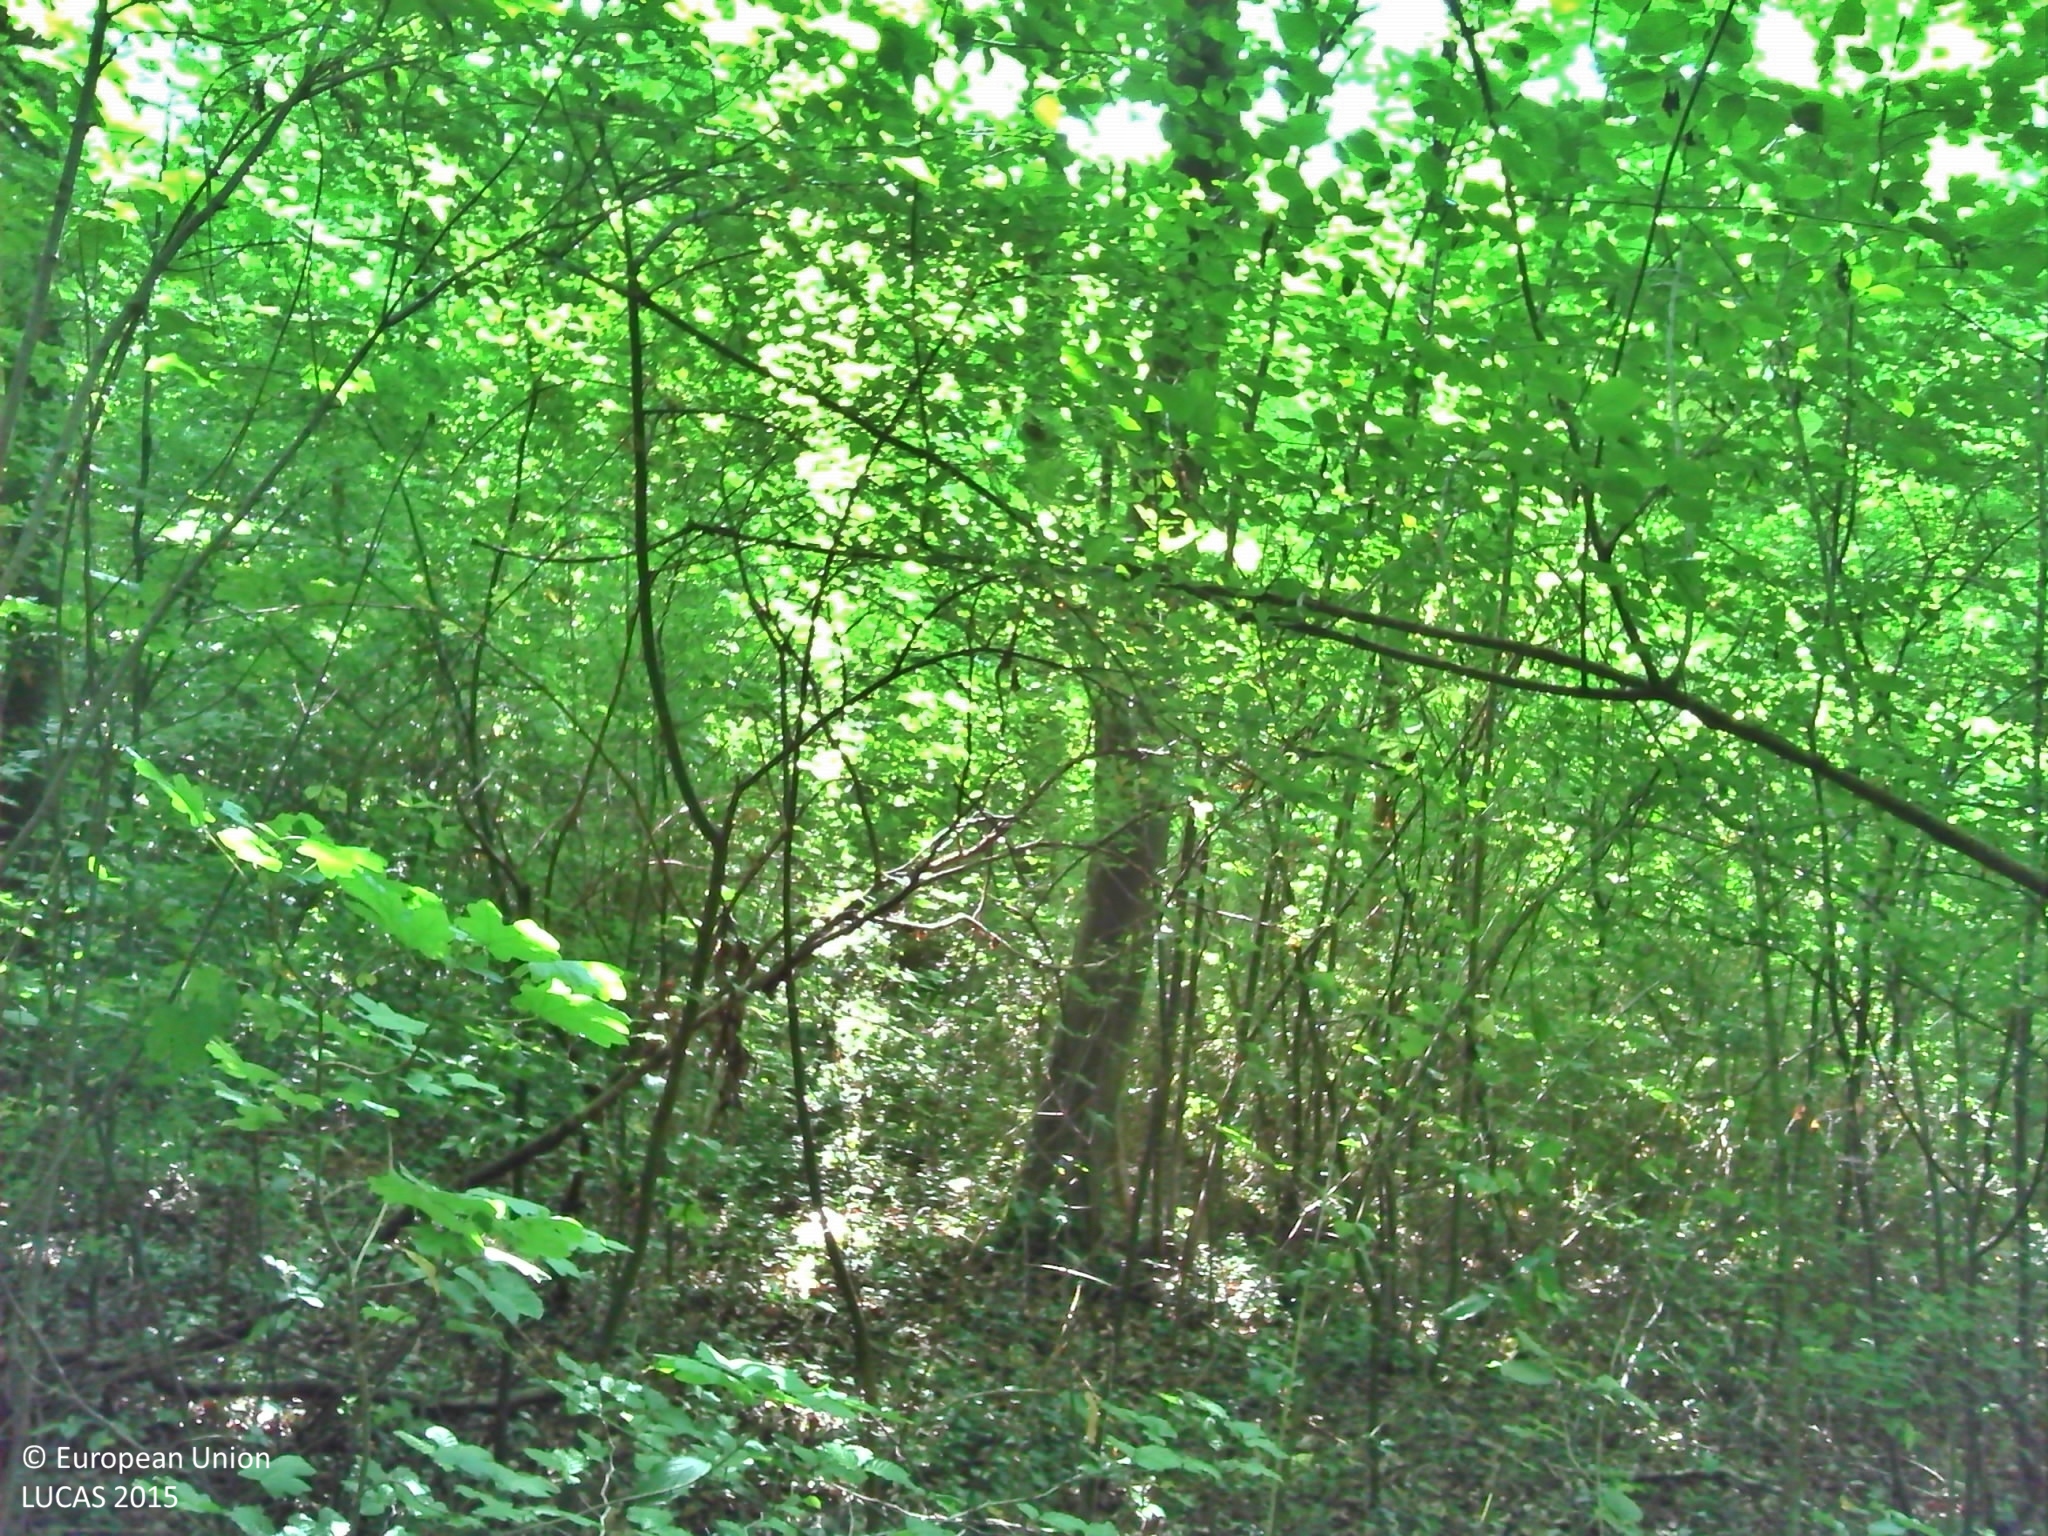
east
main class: Woodland
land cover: Broadleaved woodland
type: beech forest
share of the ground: > 75 %
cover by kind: broadleaved forest trees 70 %, shrubs 15 %, herbaceous plants 15 %
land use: Forestry
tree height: > 5 m
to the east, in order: Broadleaved woodland; Tracks; Broadleaved woodland; Tracks; Broadleaved woodland; Fences; Common wheat; Fences; Broadleaved woodland; Tracks; Broadleaved woodland
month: July
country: FR
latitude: 49.2951
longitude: 2.3559
